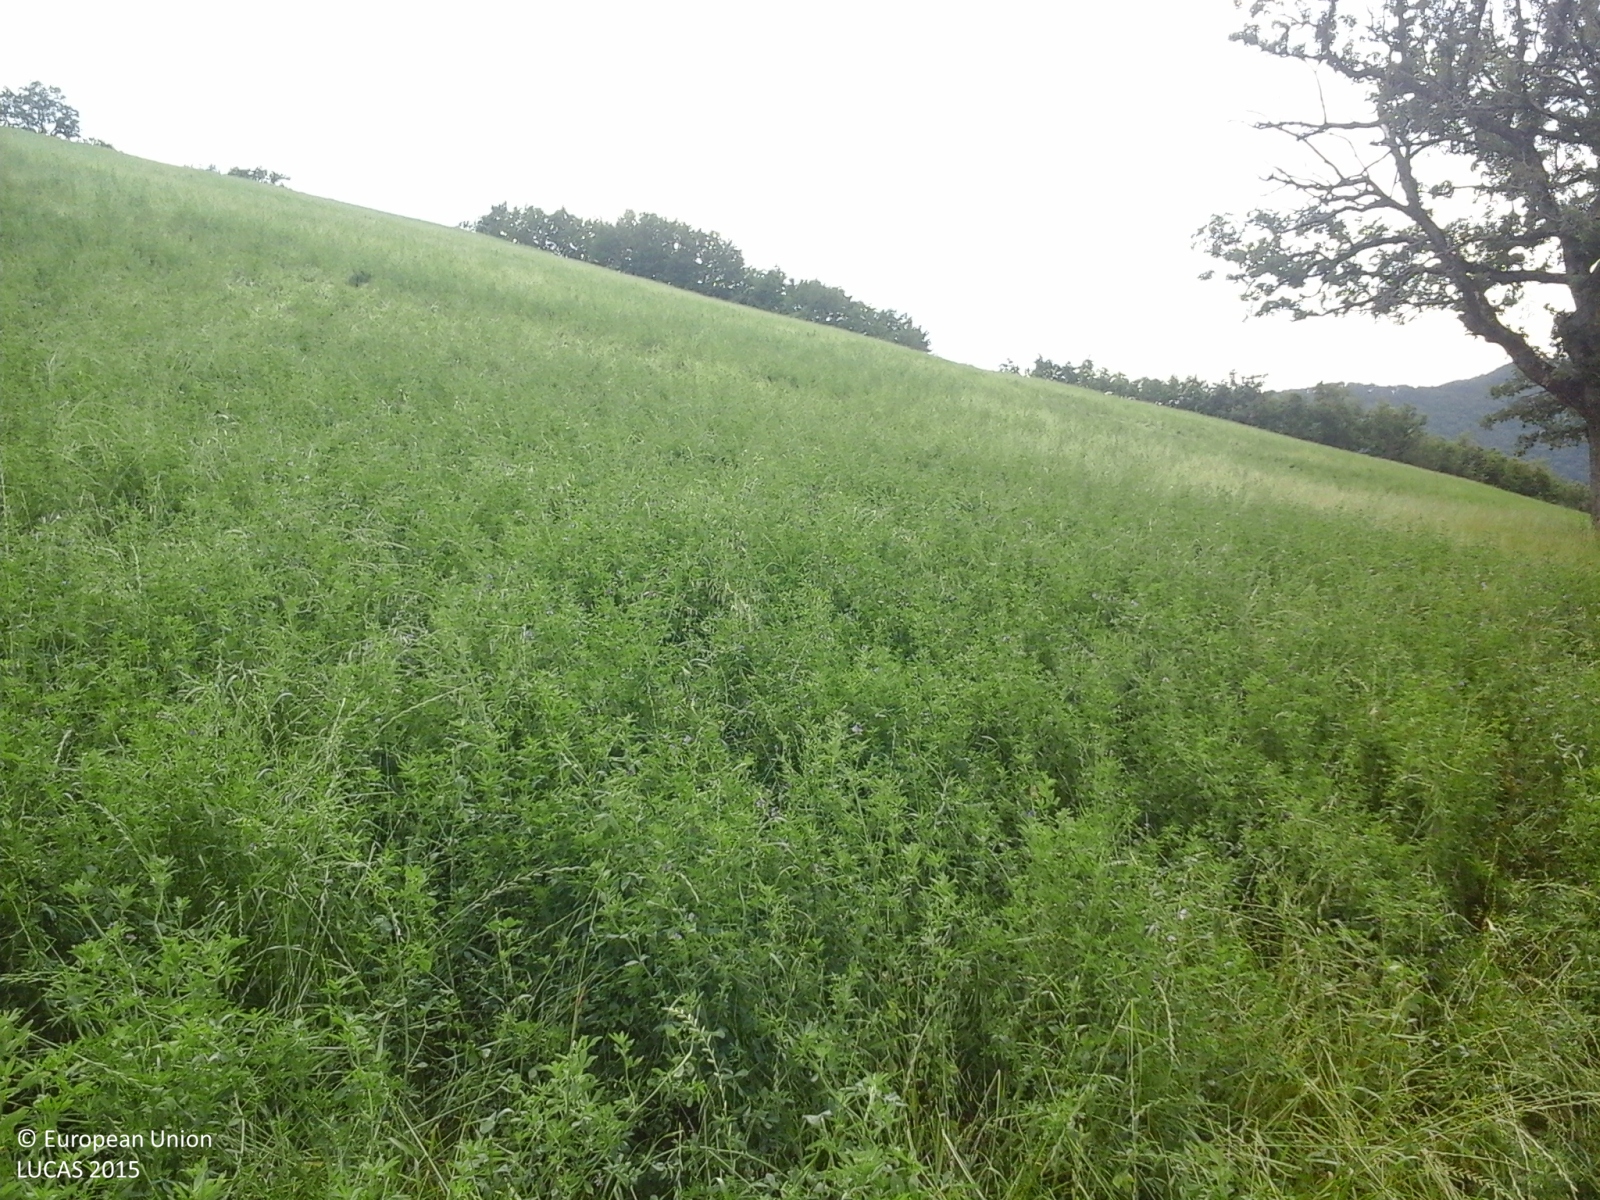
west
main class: Cropland
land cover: Lucerne
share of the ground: > 75 %
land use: Agriculture (excluding fallow land and kitchen gardens)
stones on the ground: < 10 %
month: June
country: IT
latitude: 44.1938
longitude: 11.6103
